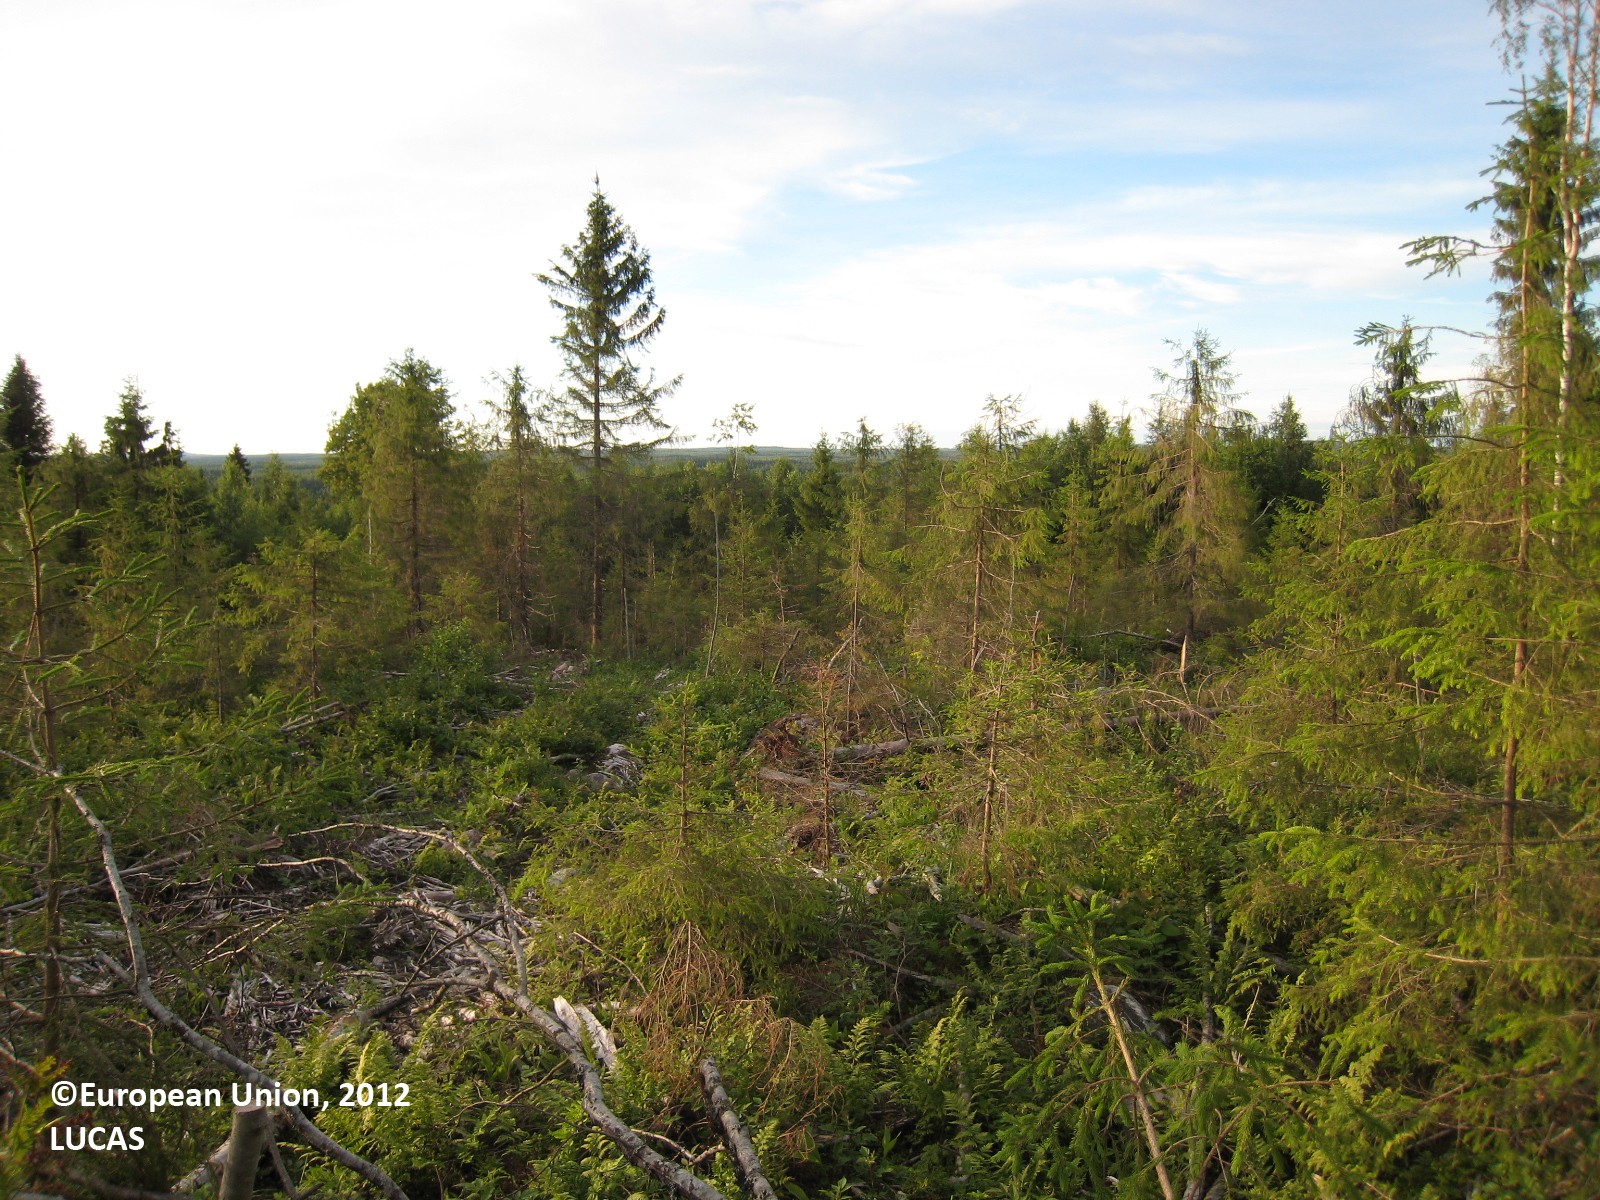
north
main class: Woodland
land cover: Spruce dominated coniferous woodland
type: boreal forest
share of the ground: 25 - 50 %
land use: Forestry
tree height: > 5 m
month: July
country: FI
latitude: 63.1636
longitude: 26.9195
